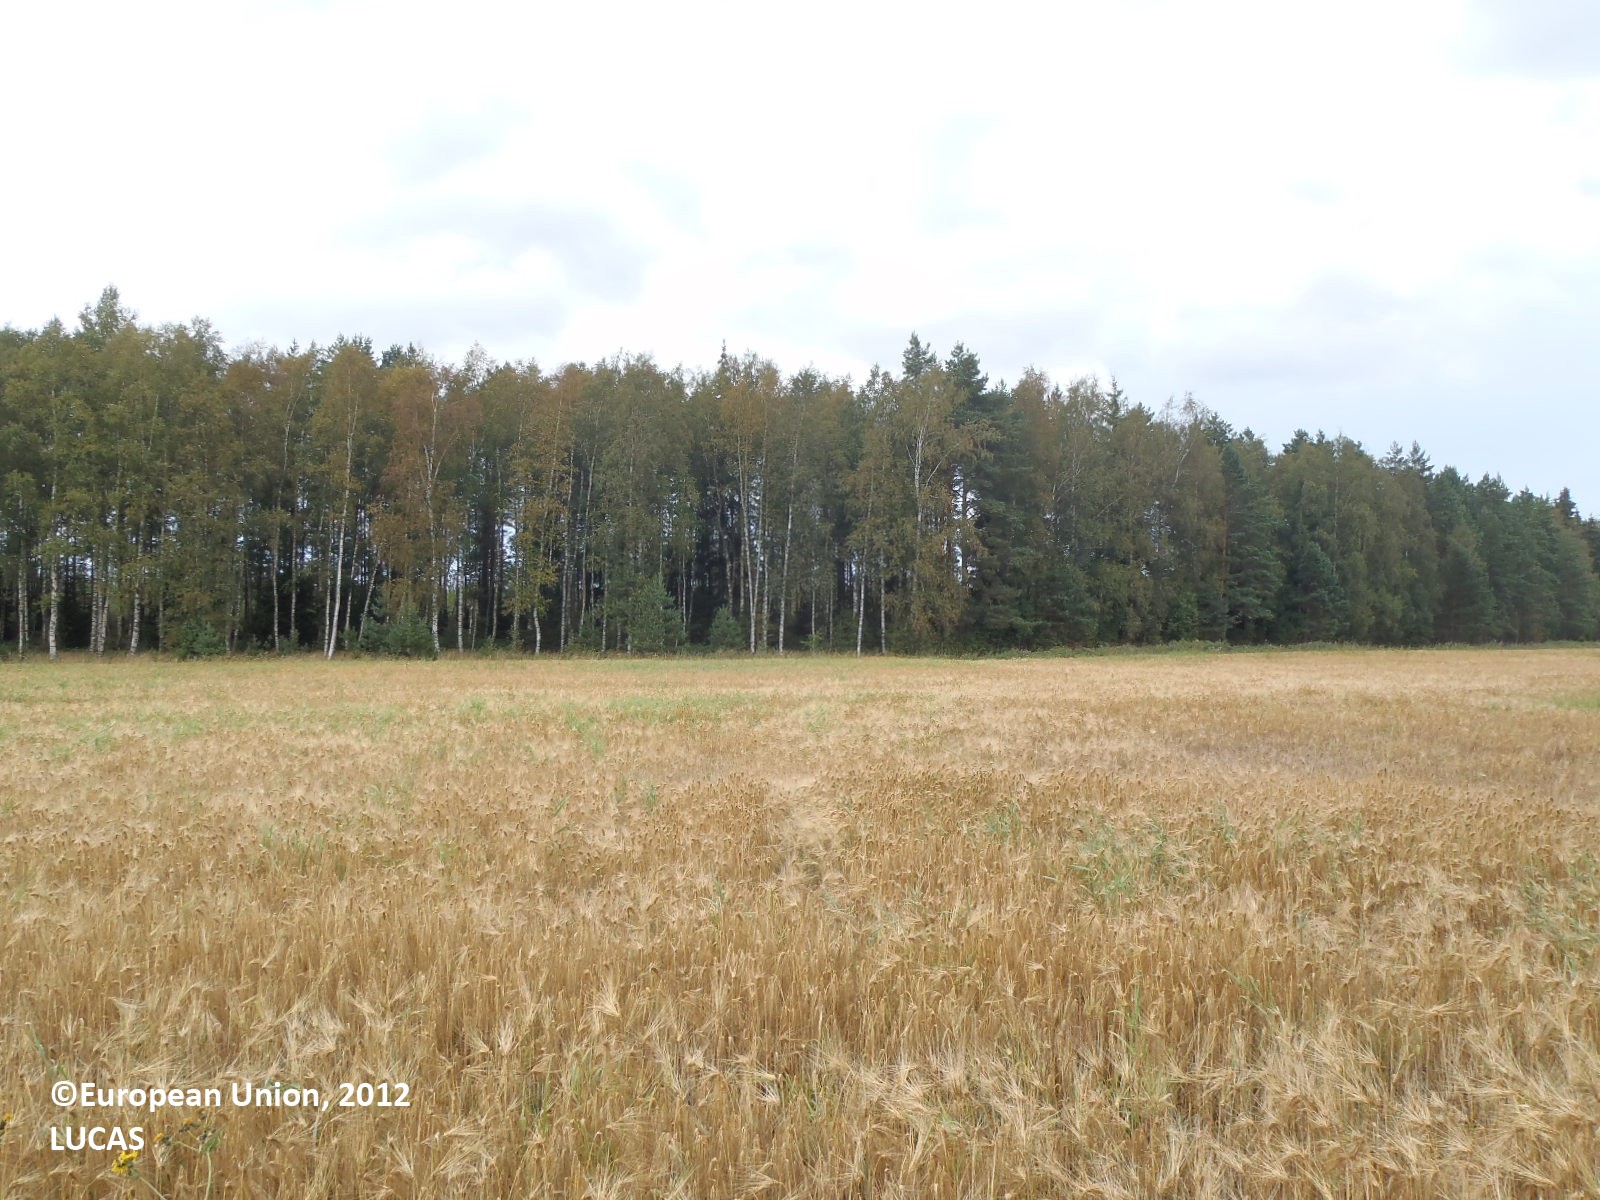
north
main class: Cropland
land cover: Barley
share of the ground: > 75 %
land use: Agriculture (excluding fallow land and kitchen gardens)
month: August
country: FI
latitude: 60.6178
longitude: 22.1791
